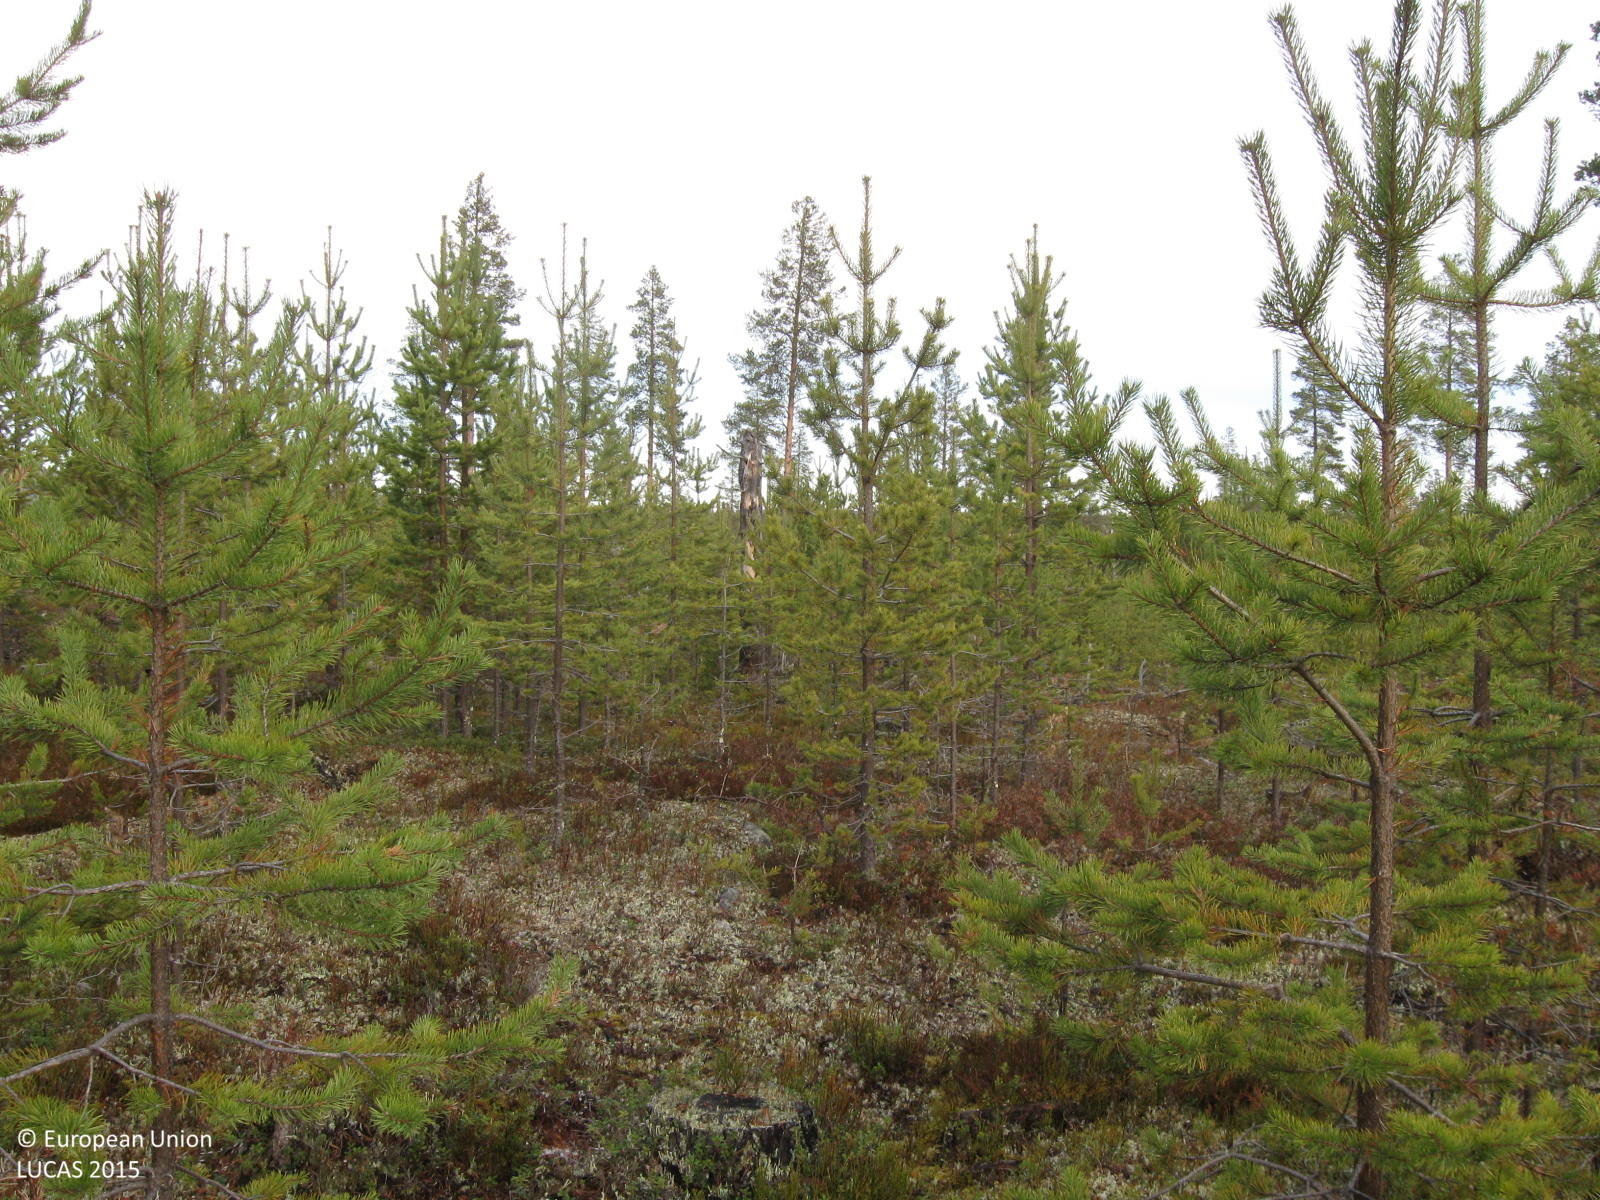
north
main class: Woodland
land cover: Pine dominated coniferous woodland
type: boreal forest
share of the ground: 50 - 75 %
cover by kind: coniferous forest trees 65 %, shrubs 15 %, lichens and mosses 10 %, herbaceous plants 5 %
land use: Forestry
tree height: < 5 m
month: November
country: SE
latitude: 66.0532
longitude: 20.5817
